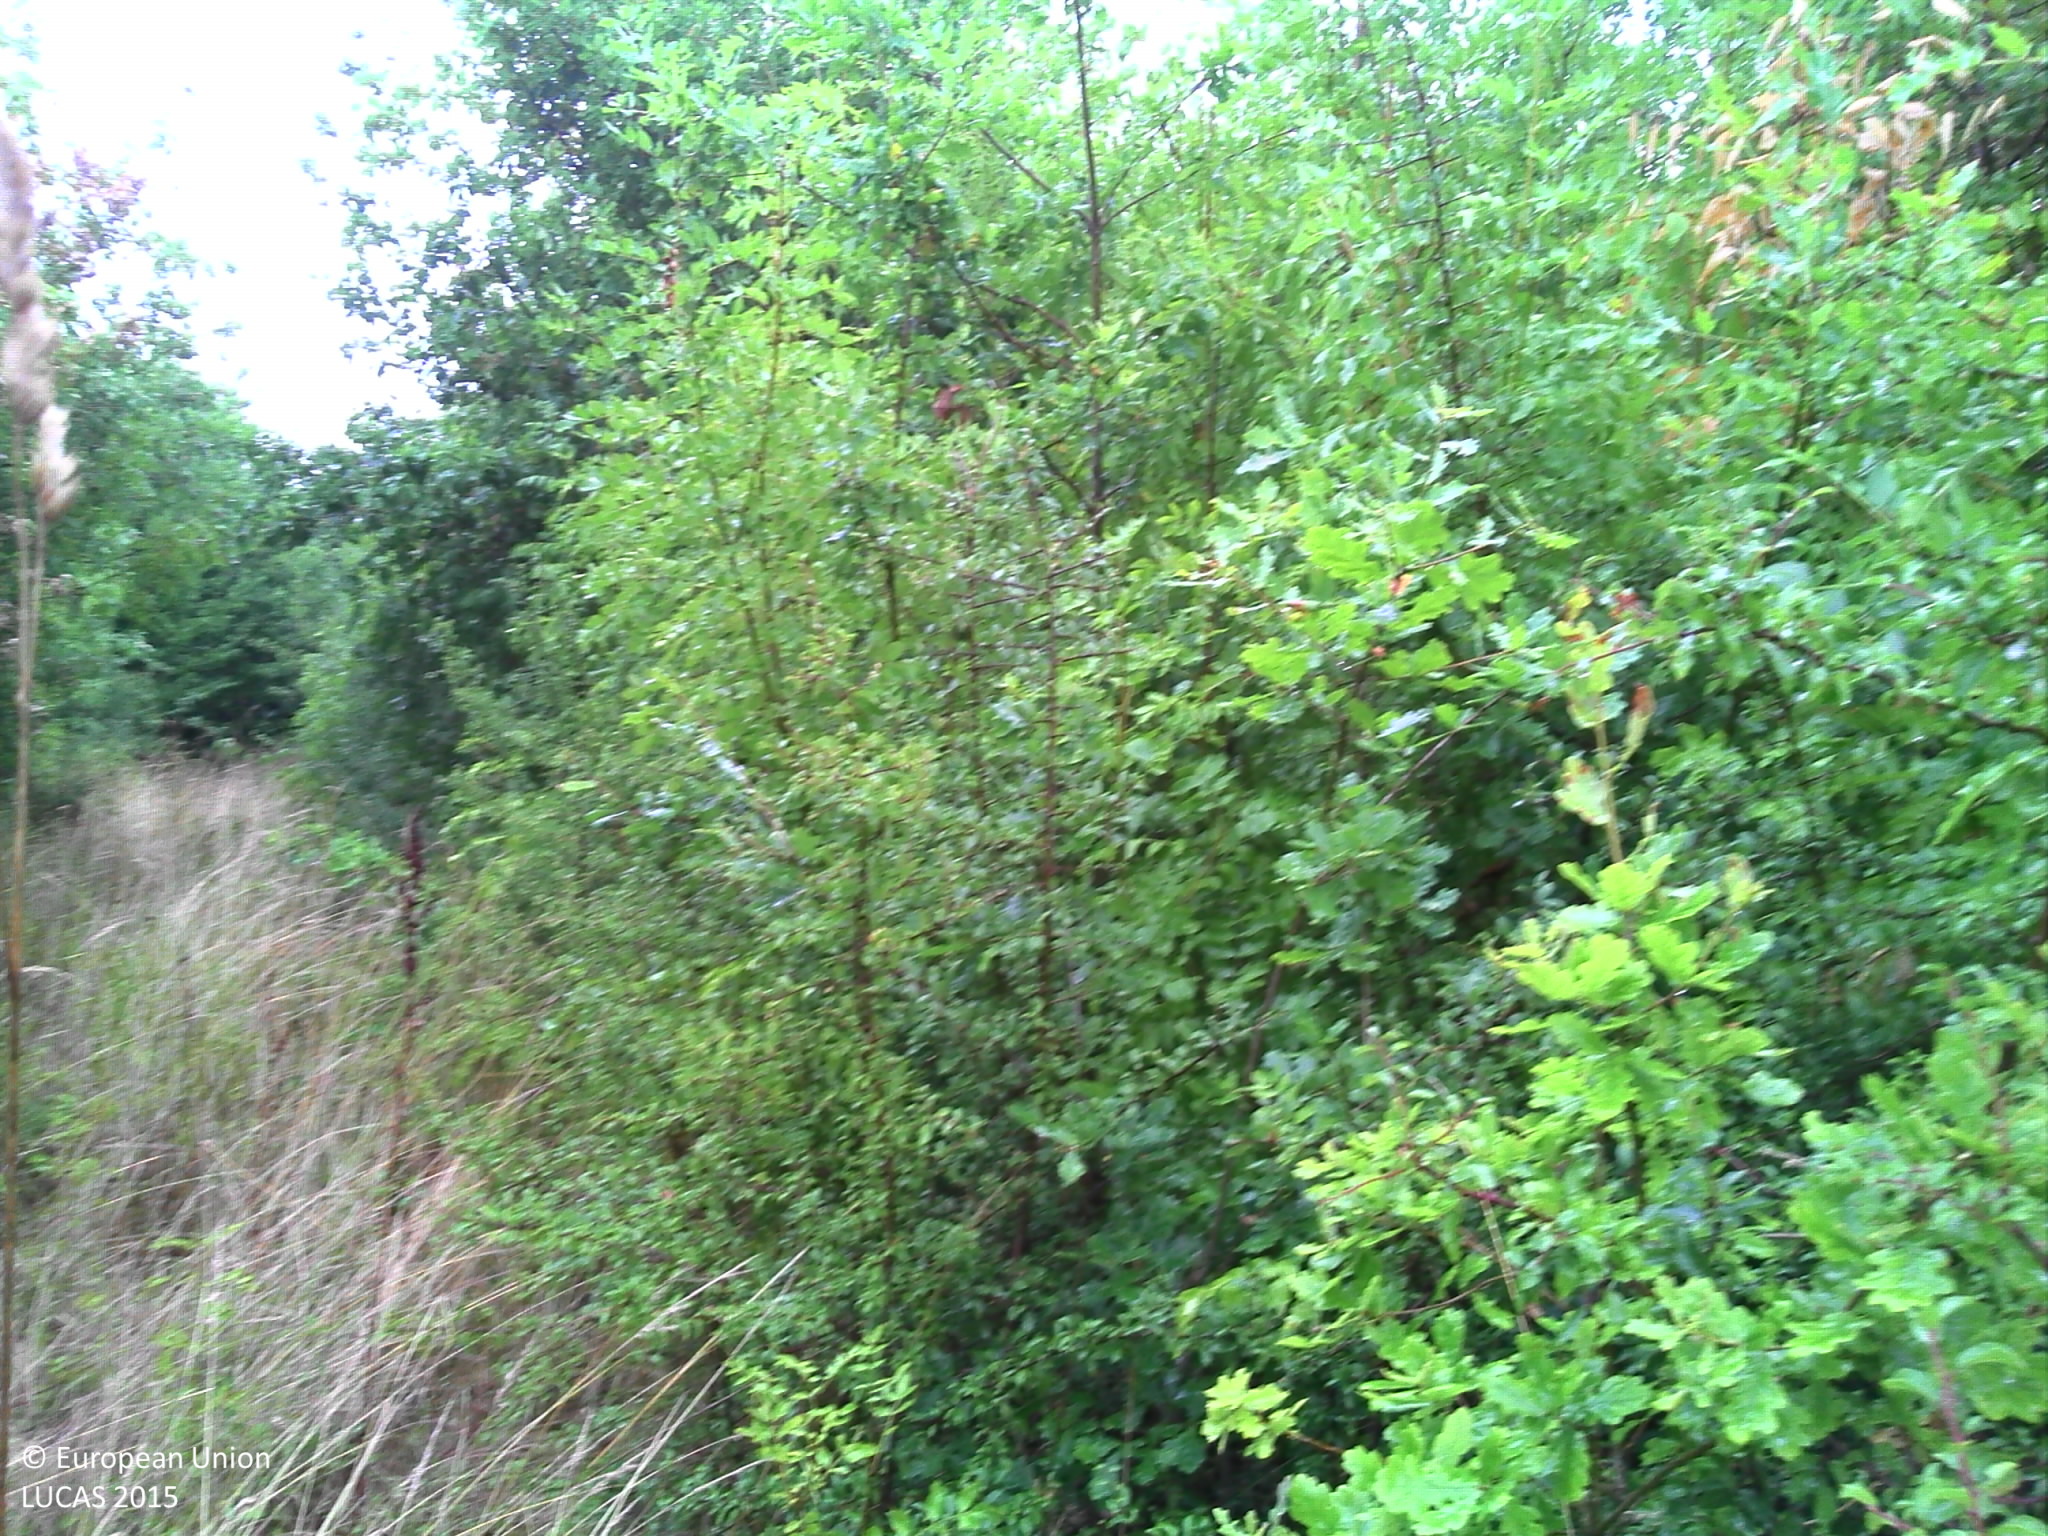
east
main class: Woodland
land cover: Broadleaved woodland
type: mesophytic deciduous forest
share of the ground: > 75 %
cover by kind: broadleaved forest trees 100 %
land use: Forestry
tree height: > 5 m
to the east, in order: Broadleaved woodland; Tracks; Broadleaved woodland; Artificial constructions in urban areas
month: July
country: FR
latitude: 47.8429
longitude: 2.0110
